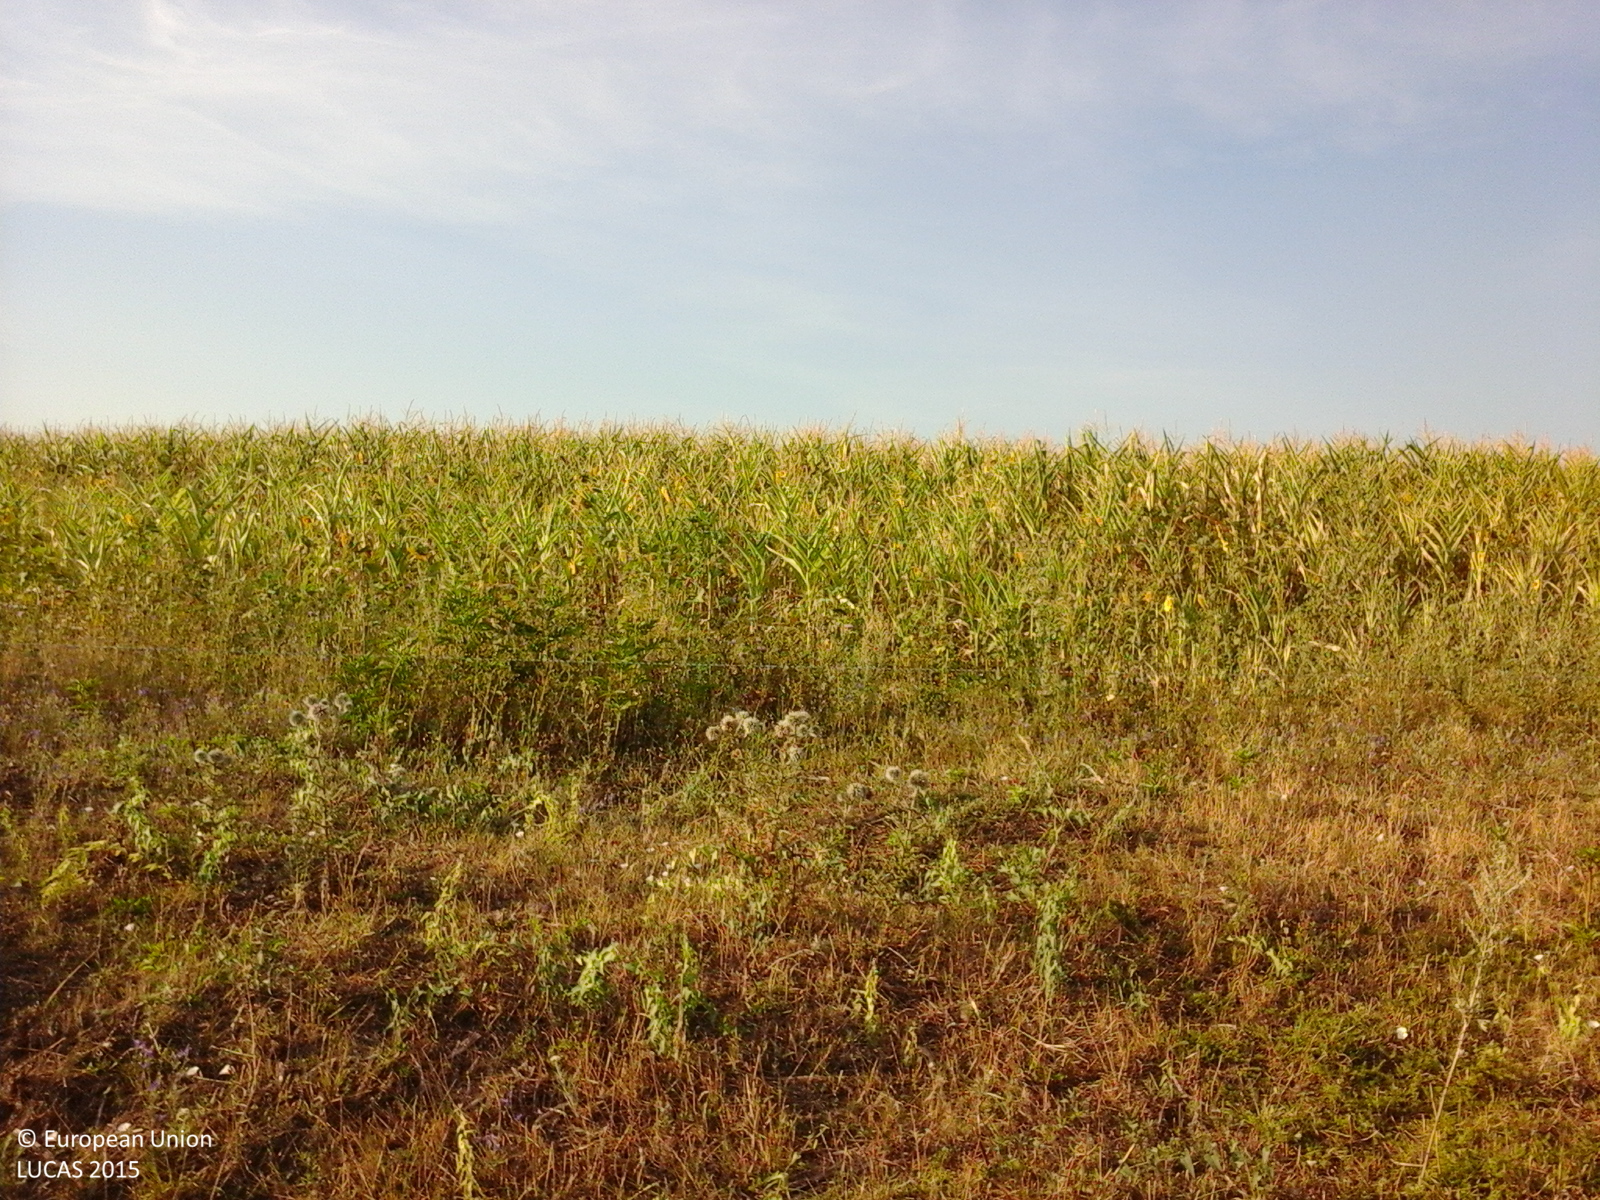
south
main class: Grassland
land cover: Grassland without tree/shrub cover
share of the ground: > 75 %
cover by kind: herbaceous plants 100 %
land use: Agriculture (excluding fallow land and kitchen gardens)
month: July
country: RO
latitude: 46.1876
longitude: 28.0170
